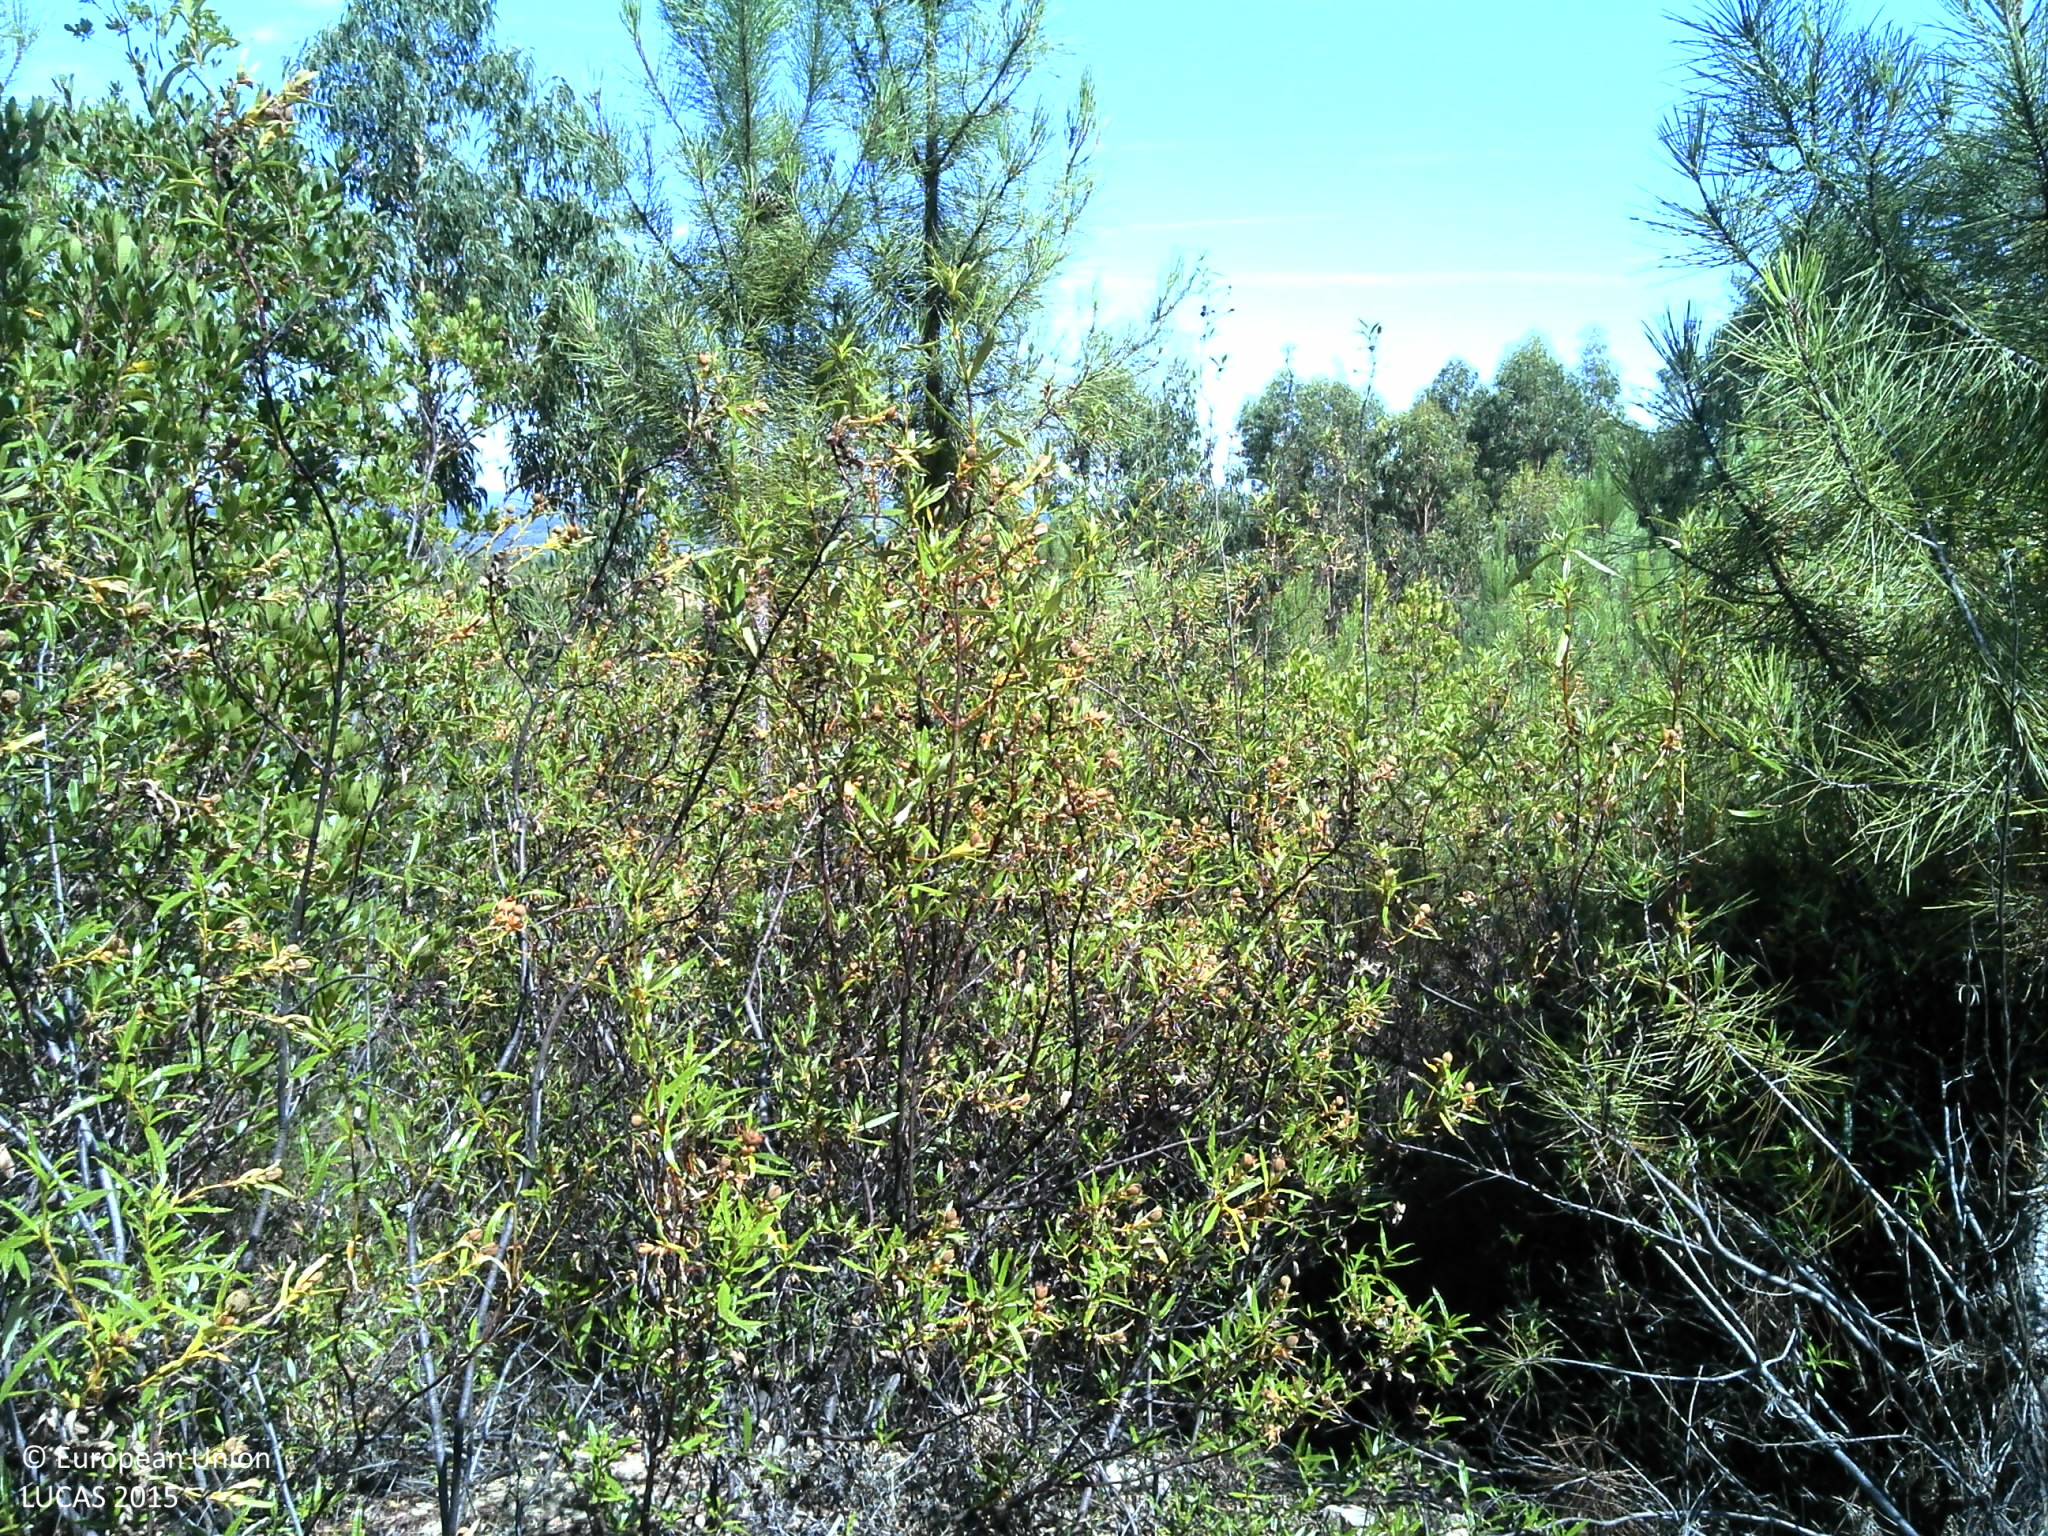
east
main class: Woodland
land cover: Pine dominated mixed woodland
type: coniferous forest of the mediterranean region
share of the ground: 25 - 50 %
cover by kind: shrubs 60 %, coniferous forest trees 15 %, broadleaved forest trees 10 %, unconsolidated bare surface 10 %, consolidated bare surface 5 %
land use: Forestry
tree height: > 5 m
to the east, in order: Pine dominated mixed woodland; Pine dominated coniferous woodland; Tracks; Pine dominated coniferous woodland
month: July
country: PT
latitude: 39.8066
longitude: -7.8022
